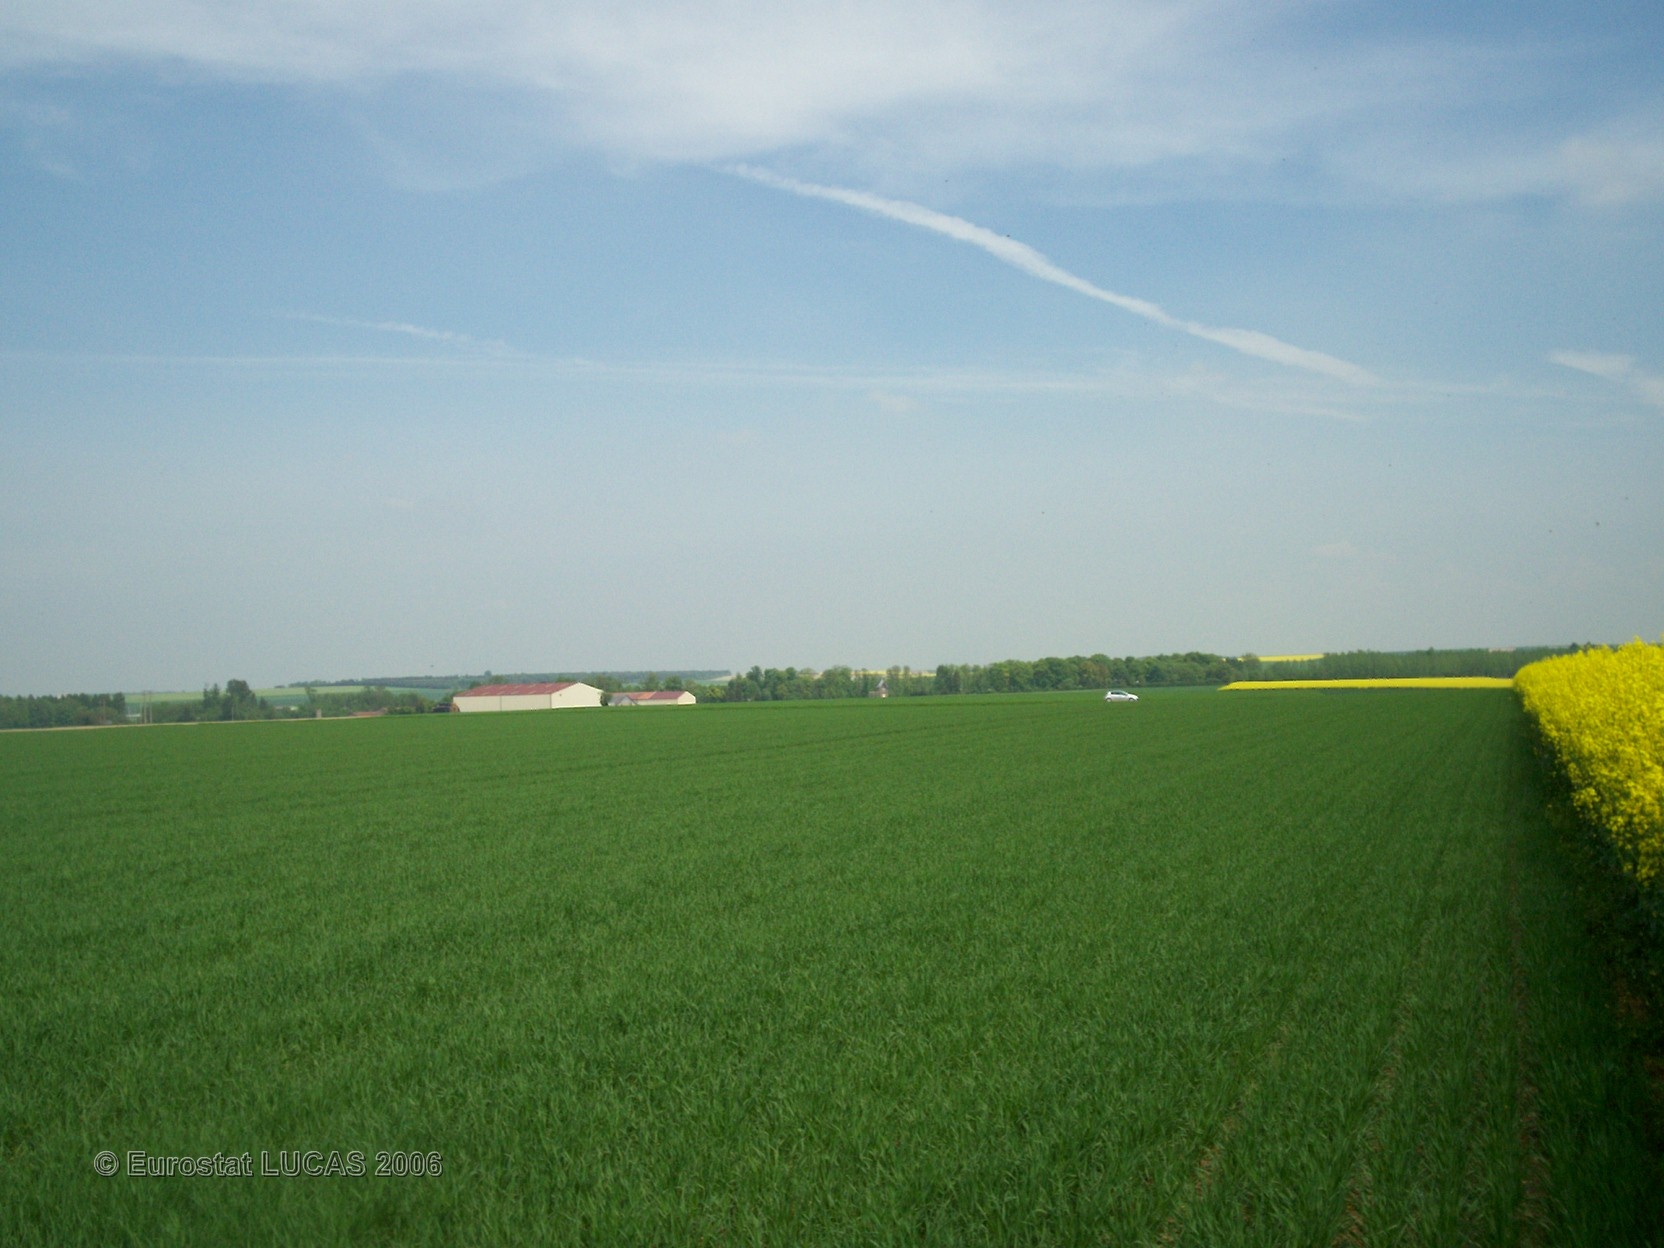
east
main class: Cropland
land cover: Rape and turnip rape
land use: Agriculture (excluding fallow land and kitchen gardens)
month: May
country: FR
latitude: 48.9847
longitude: 4.4350
